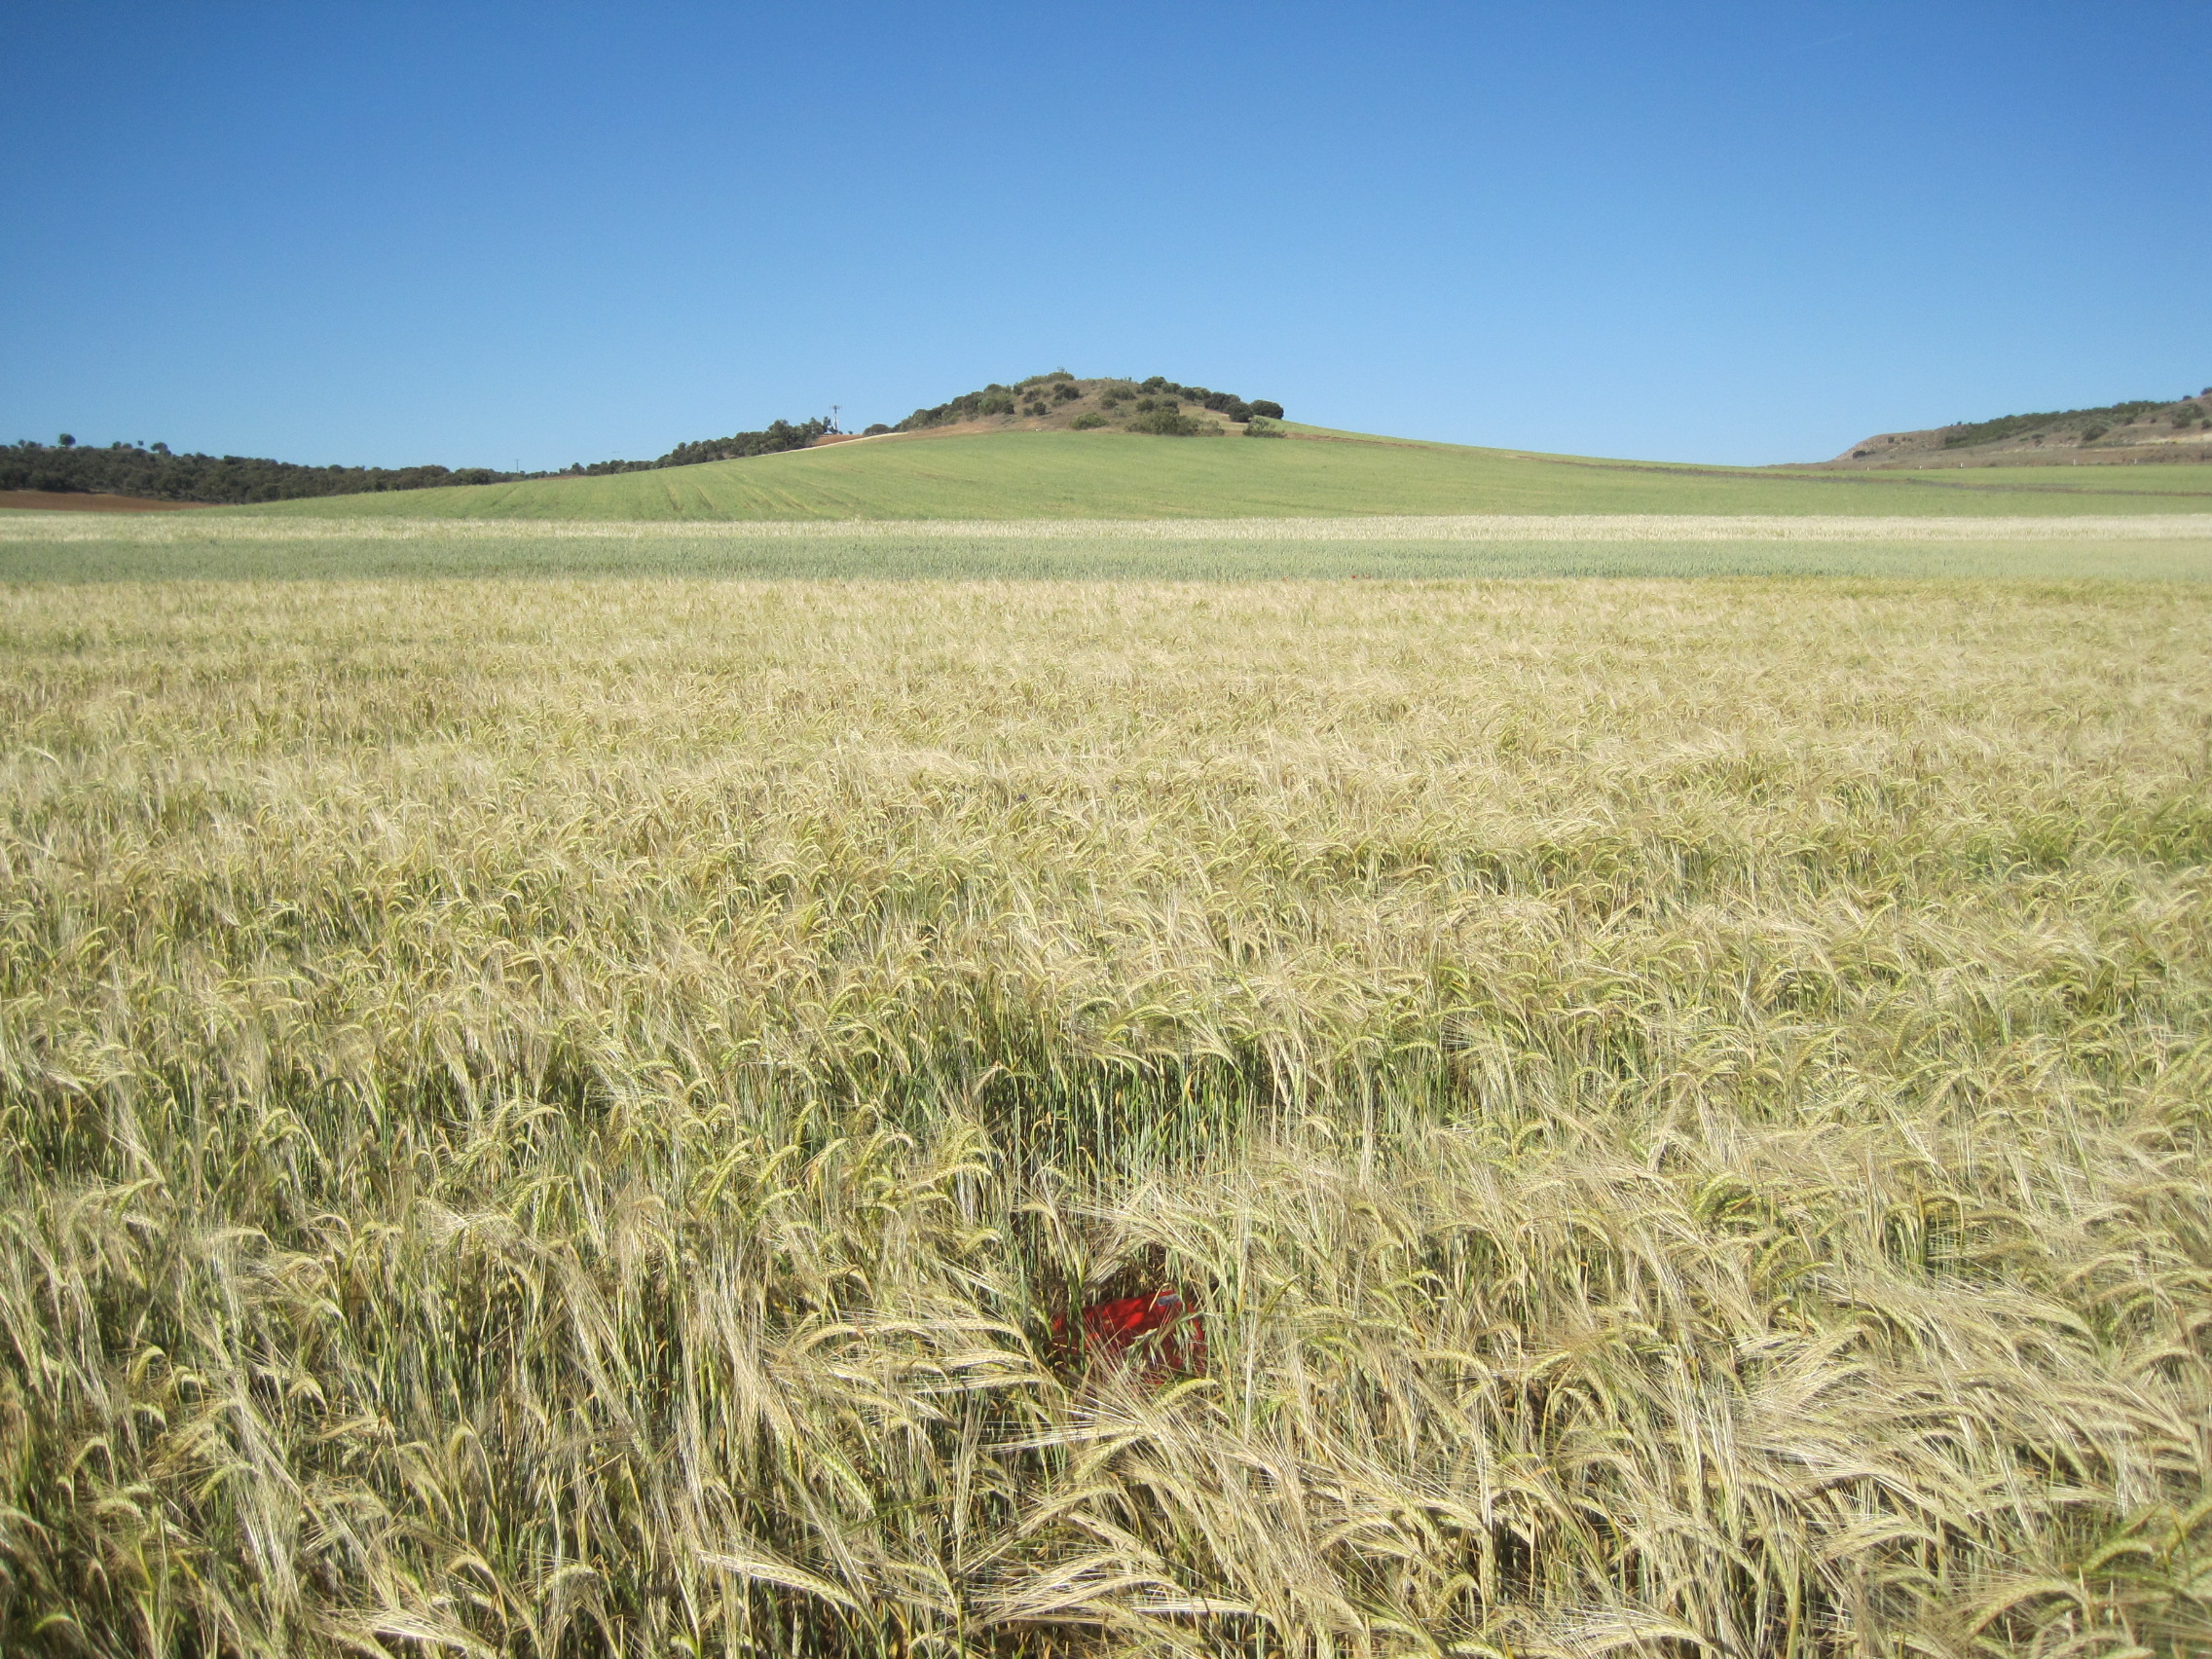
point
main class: Cropland
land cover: Barley
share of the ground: > 75 %
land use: Agriculture (excluding fallow land and kitchen gardens)
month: May
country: ES
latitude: 41.2042
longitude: -5.3267
